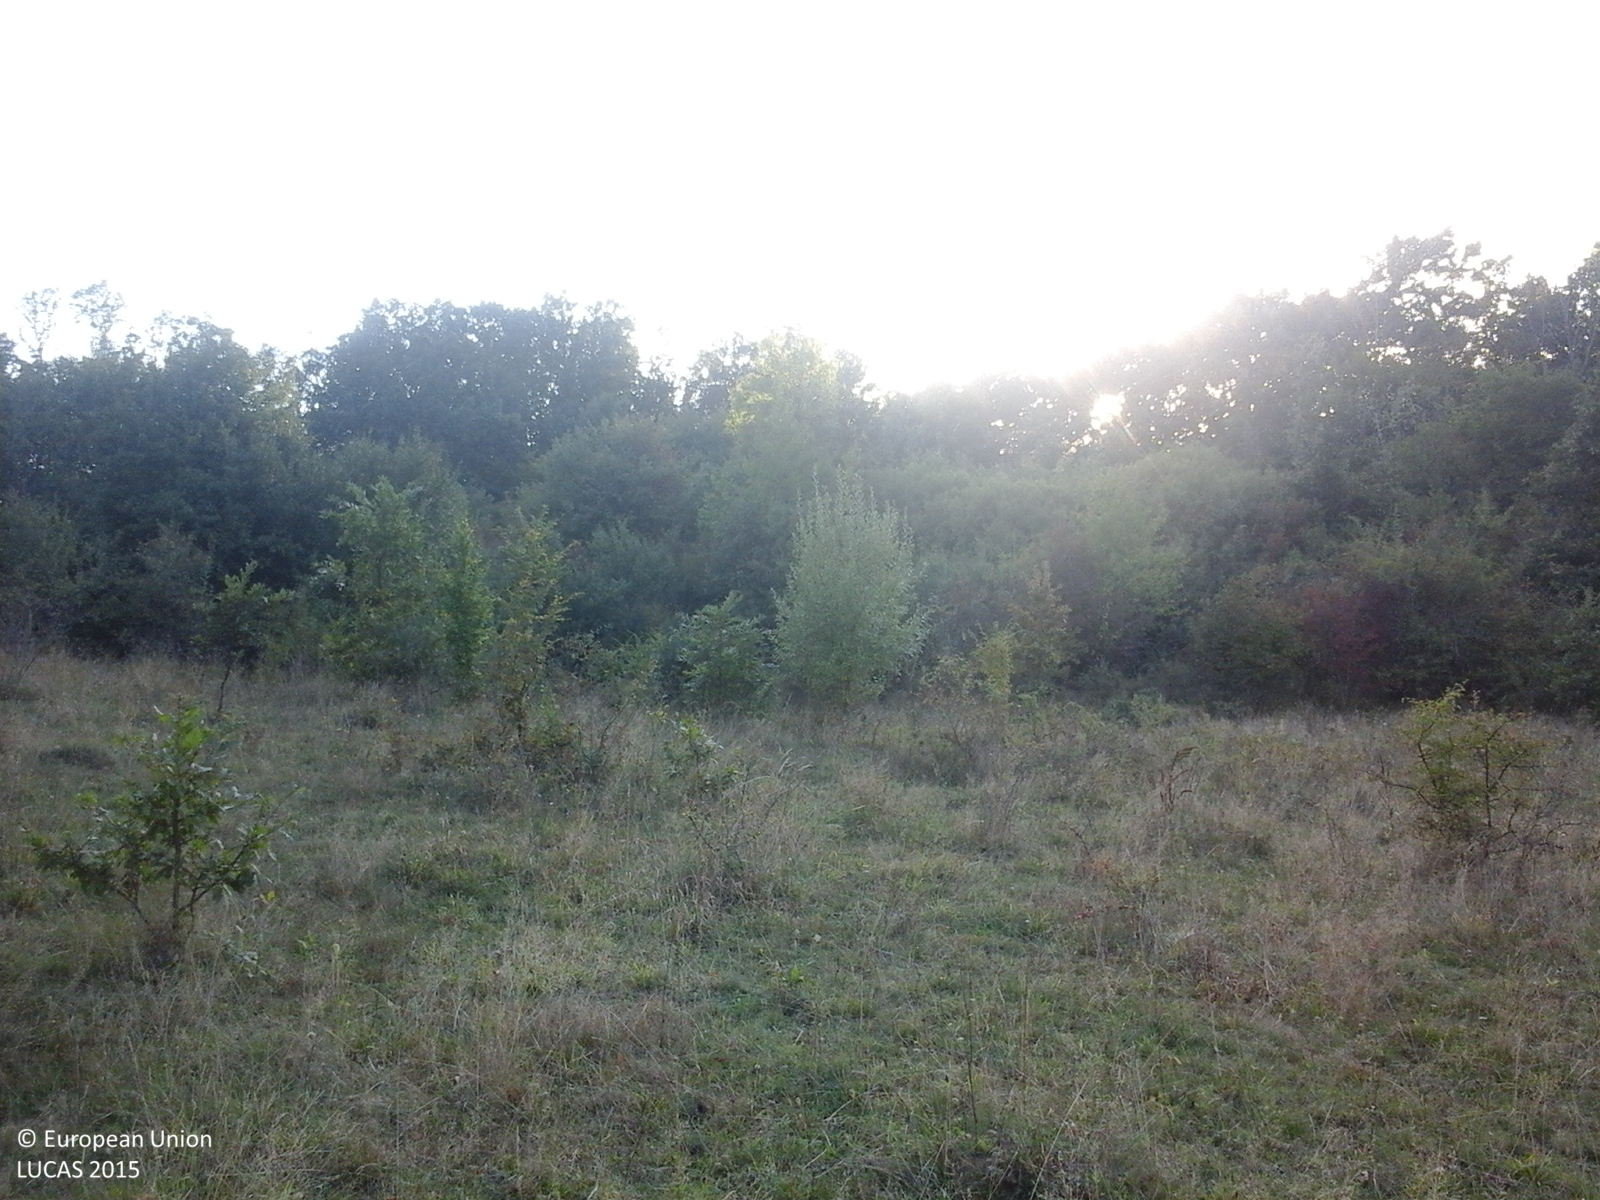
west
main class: Grassland
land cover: Grassland with sparse tree/shrub cover
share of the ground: > 75 %
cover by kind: herbaceous plants 95 %, broadleaved forest trees 5 %
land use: Fallow land
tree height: < 5 m
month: September
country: RO
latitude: 46.9975
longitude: 23.4171
